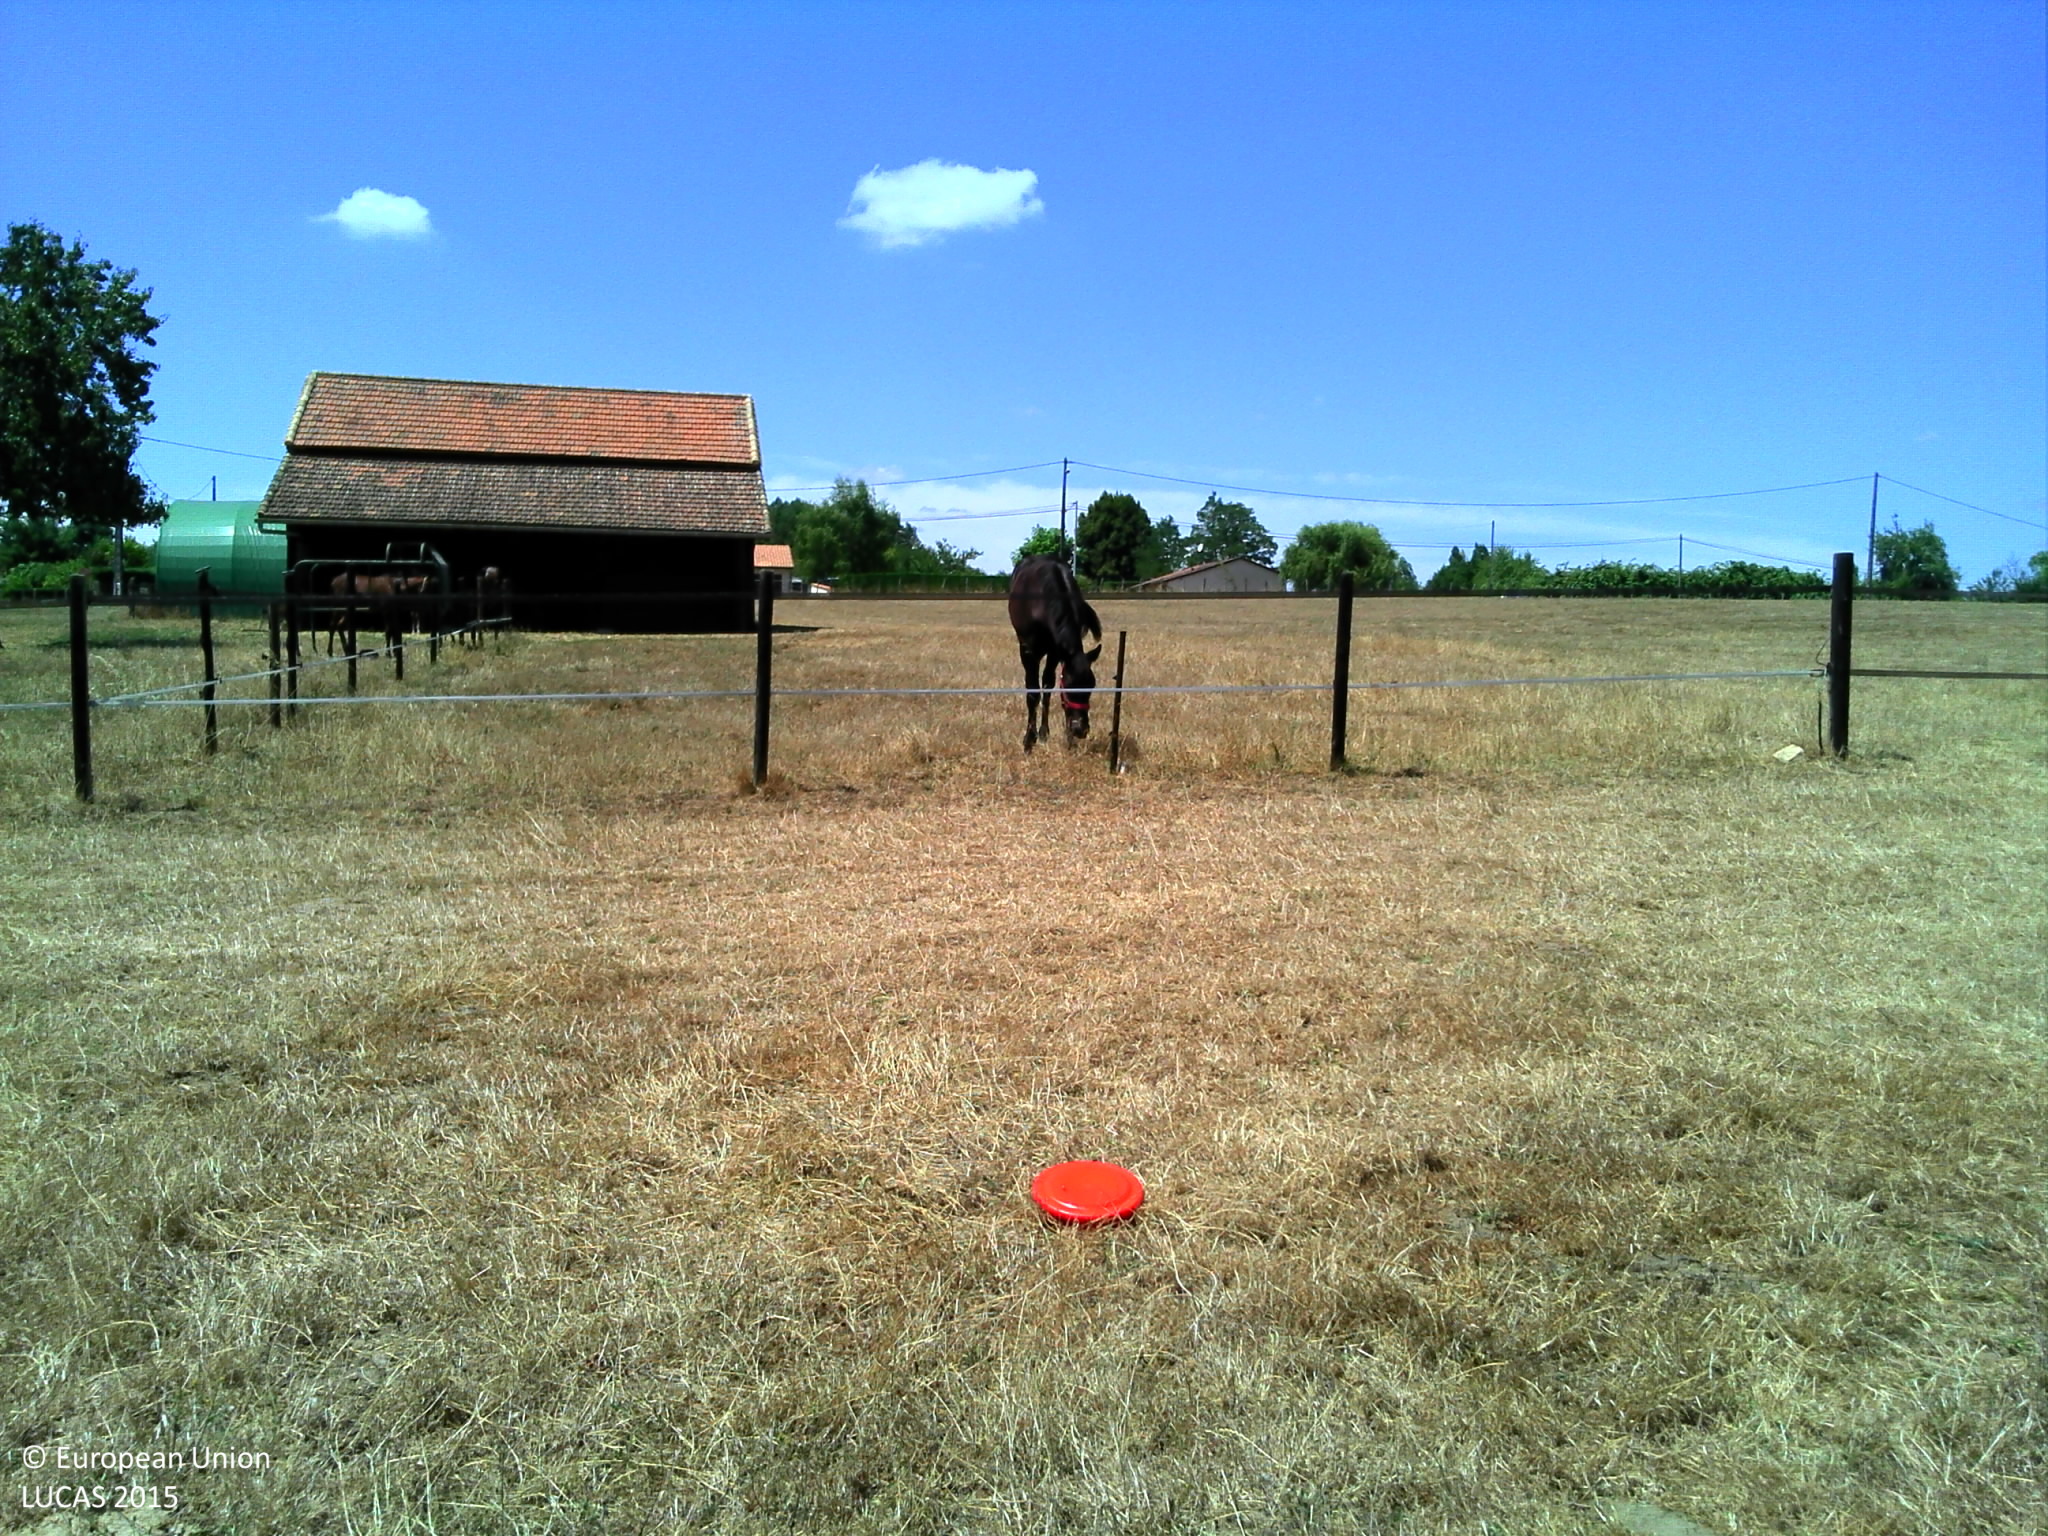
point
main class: Grassland
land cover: Grassland without tree/shrub cover
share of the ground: > 75 %
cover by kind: herbaceous plants 100 %
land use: Agriculture (excluding fallow land and kitchen gardens)
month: July
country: FR
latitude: 44.8654
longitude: 0.5872
